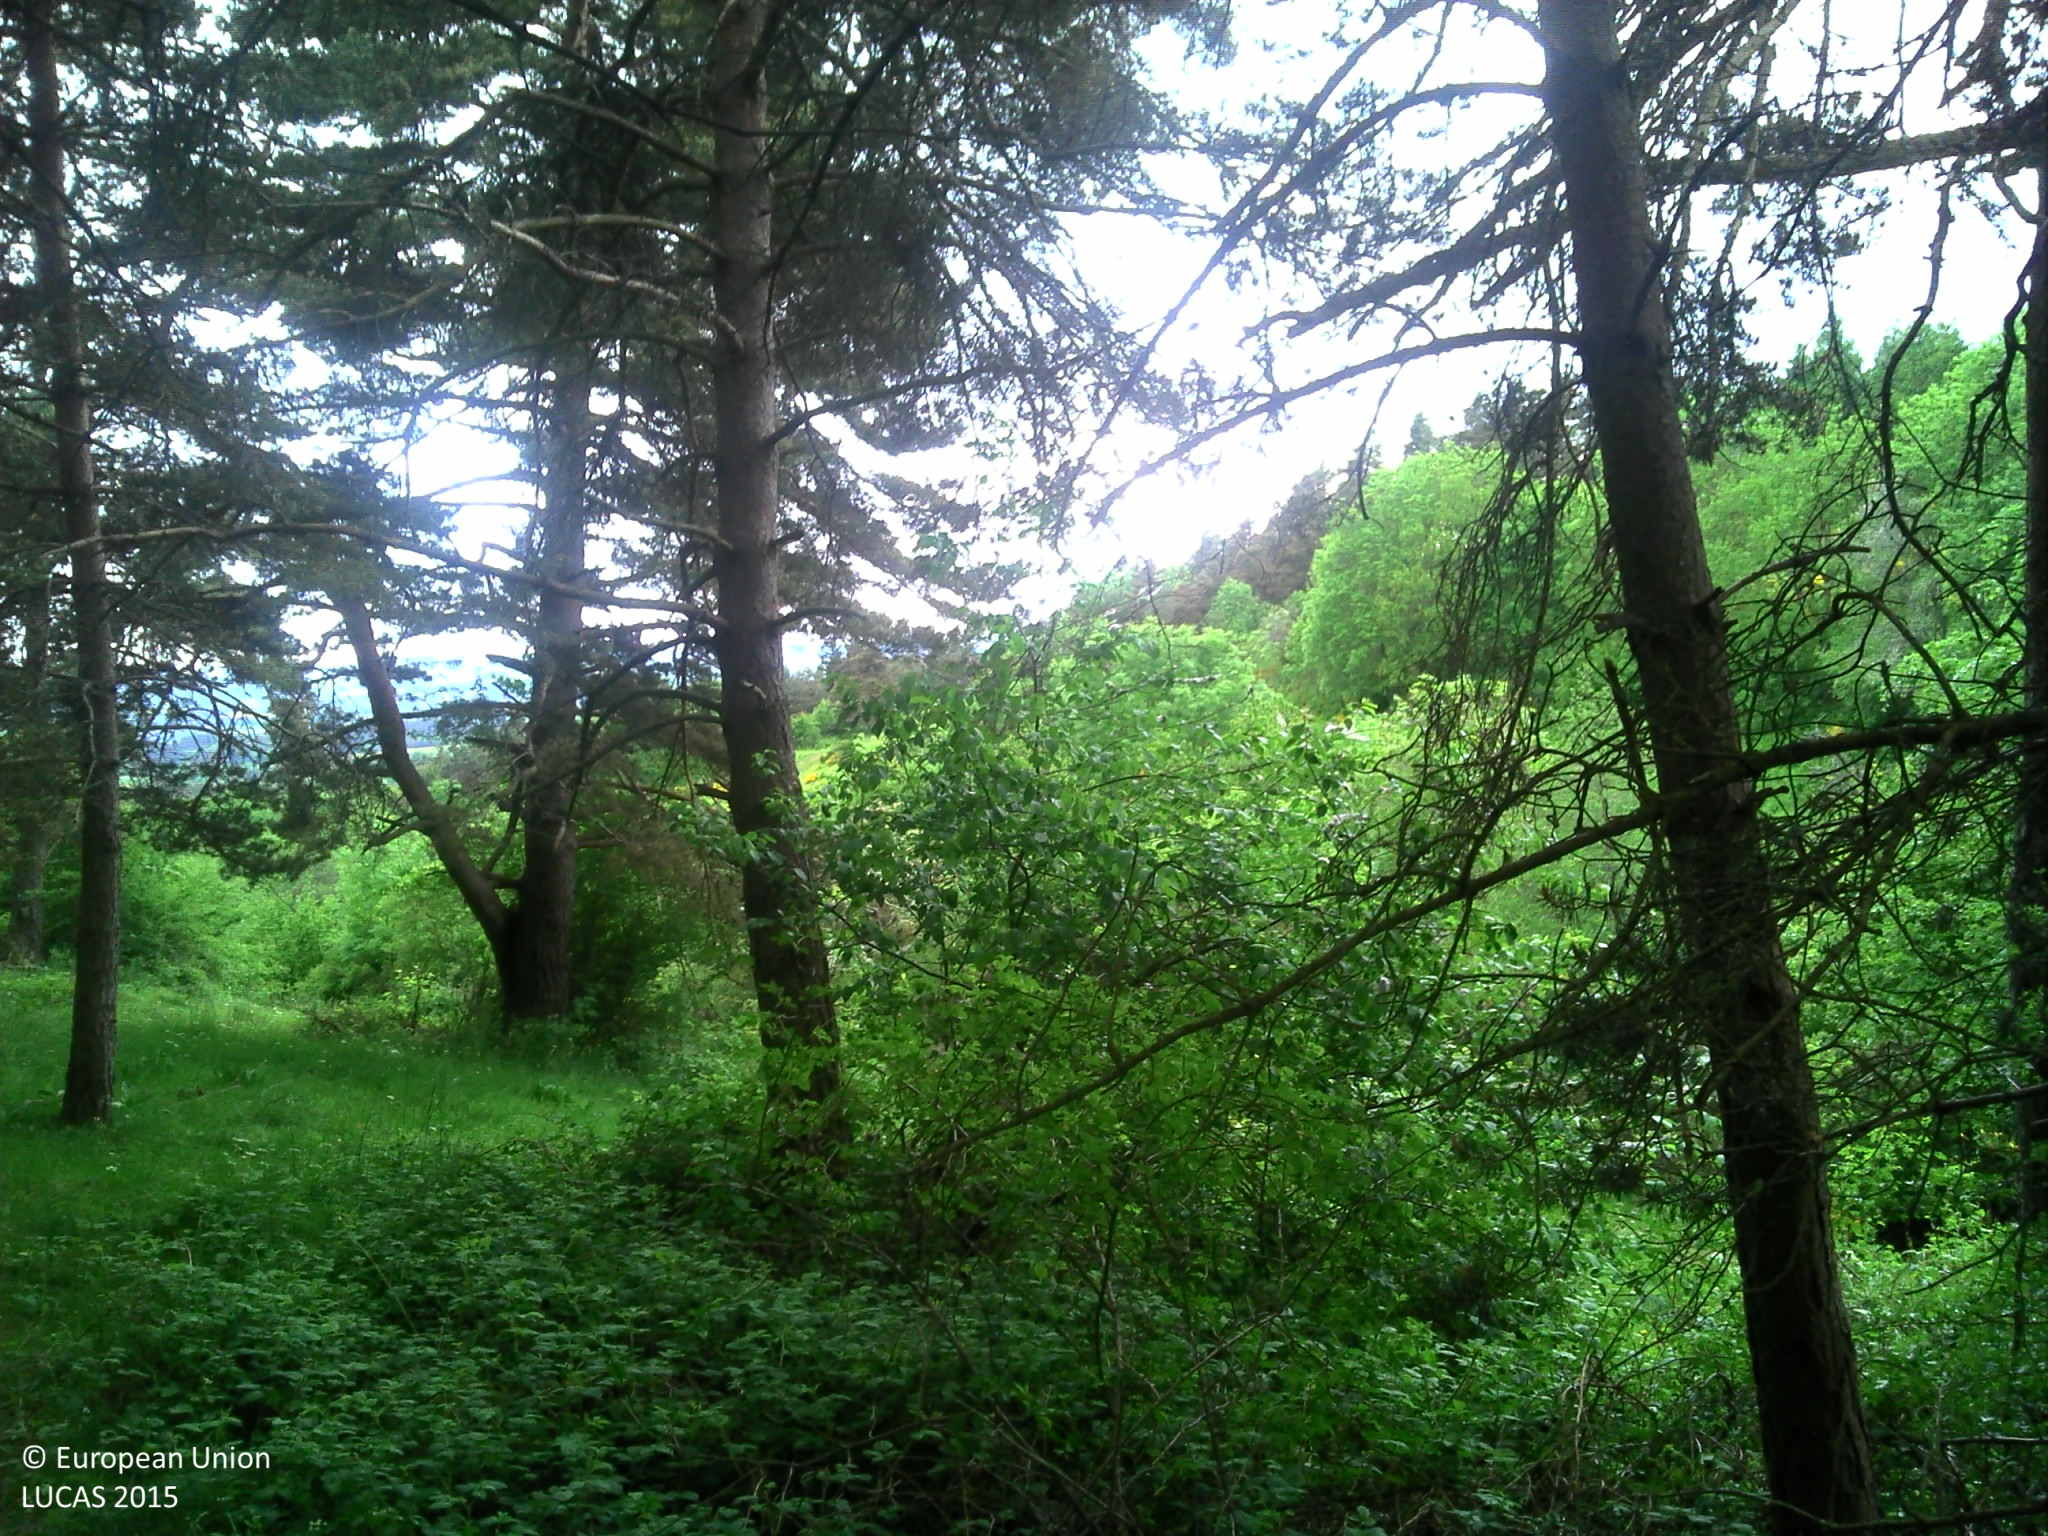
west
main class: Woodland
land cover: Pine dominated mixed woodland
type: alpine coniferous forest
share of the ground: > 75 %
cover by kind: coniferous forest trees 60 %, broadleaved forest trees 20 %, shrubs 10 %, herbaceous plants 10 %
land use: Forestry
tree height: > 5 m
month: June
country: FR
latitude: 45.0164
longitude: 3.2393
